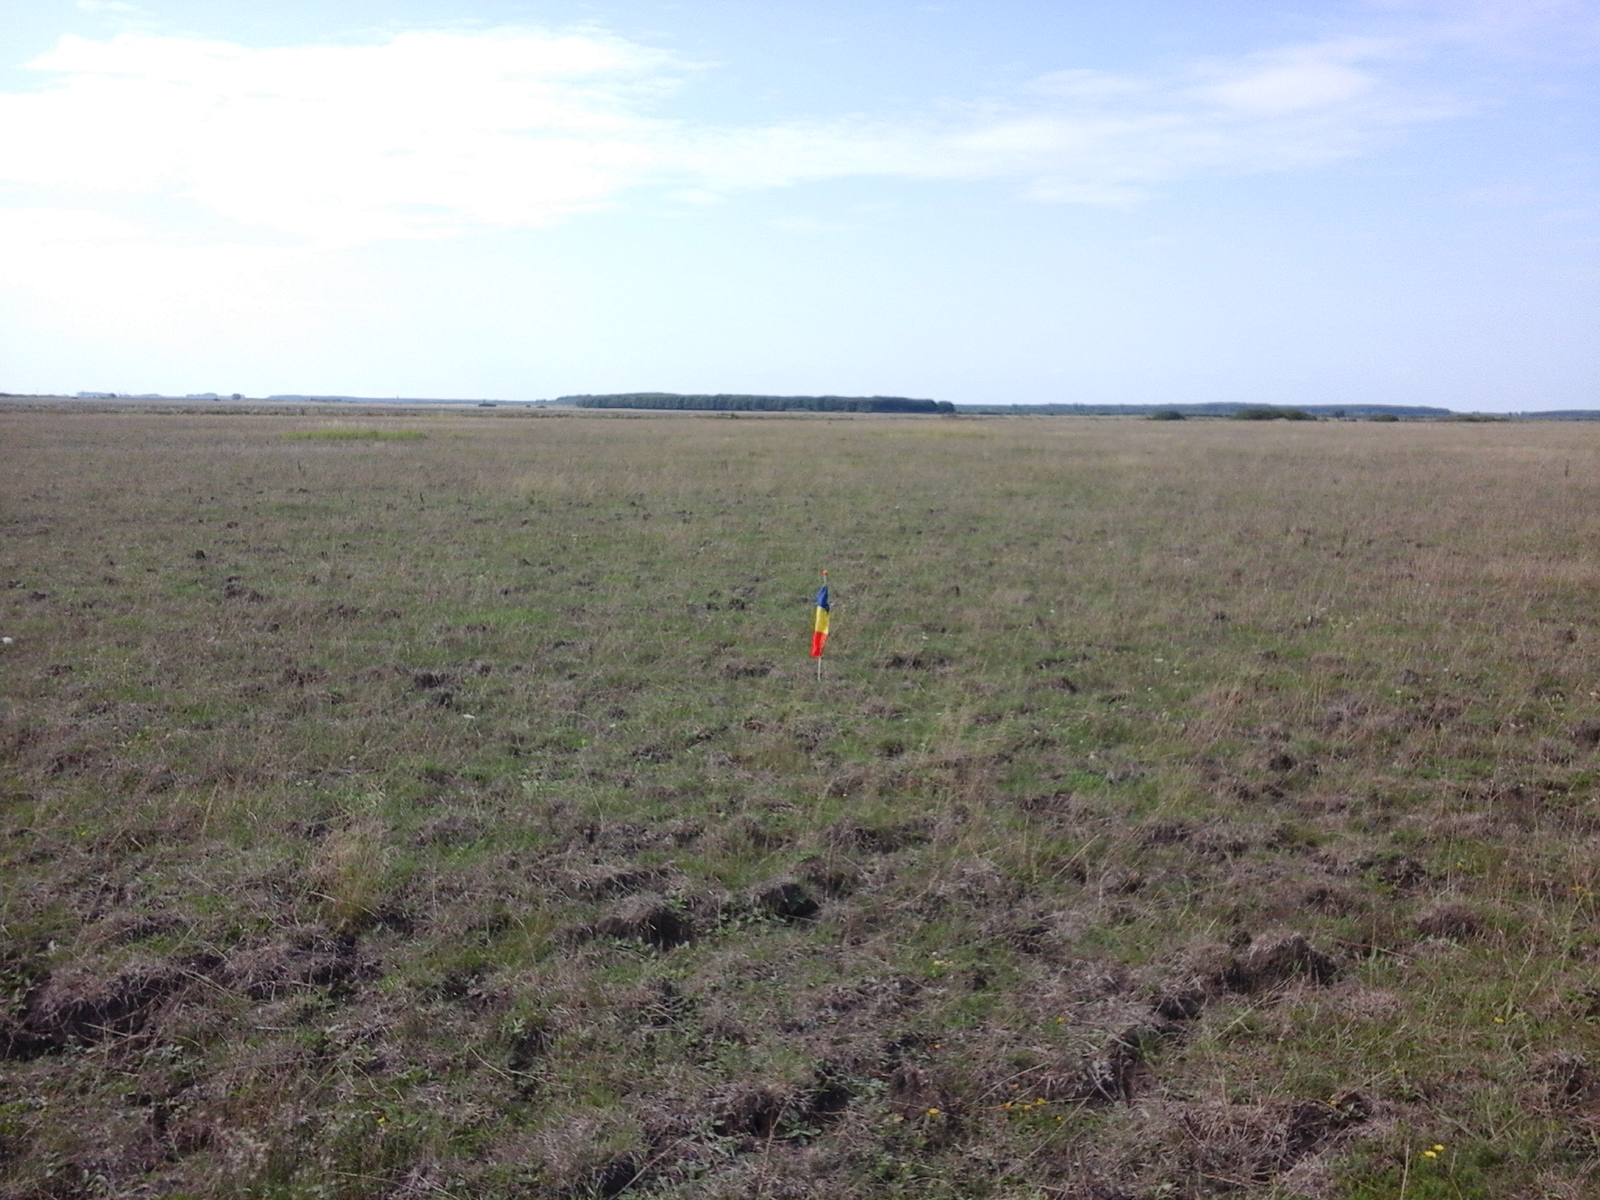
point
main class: Grassland
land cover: Grassland without tree/shrub cover
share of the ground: > 75 %
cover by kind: herbaceous plants 100 %
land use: Agriculture (excluding fallow land and kitchen gardens)
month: August
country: RO
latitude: 46.6084
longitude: 21.4356
